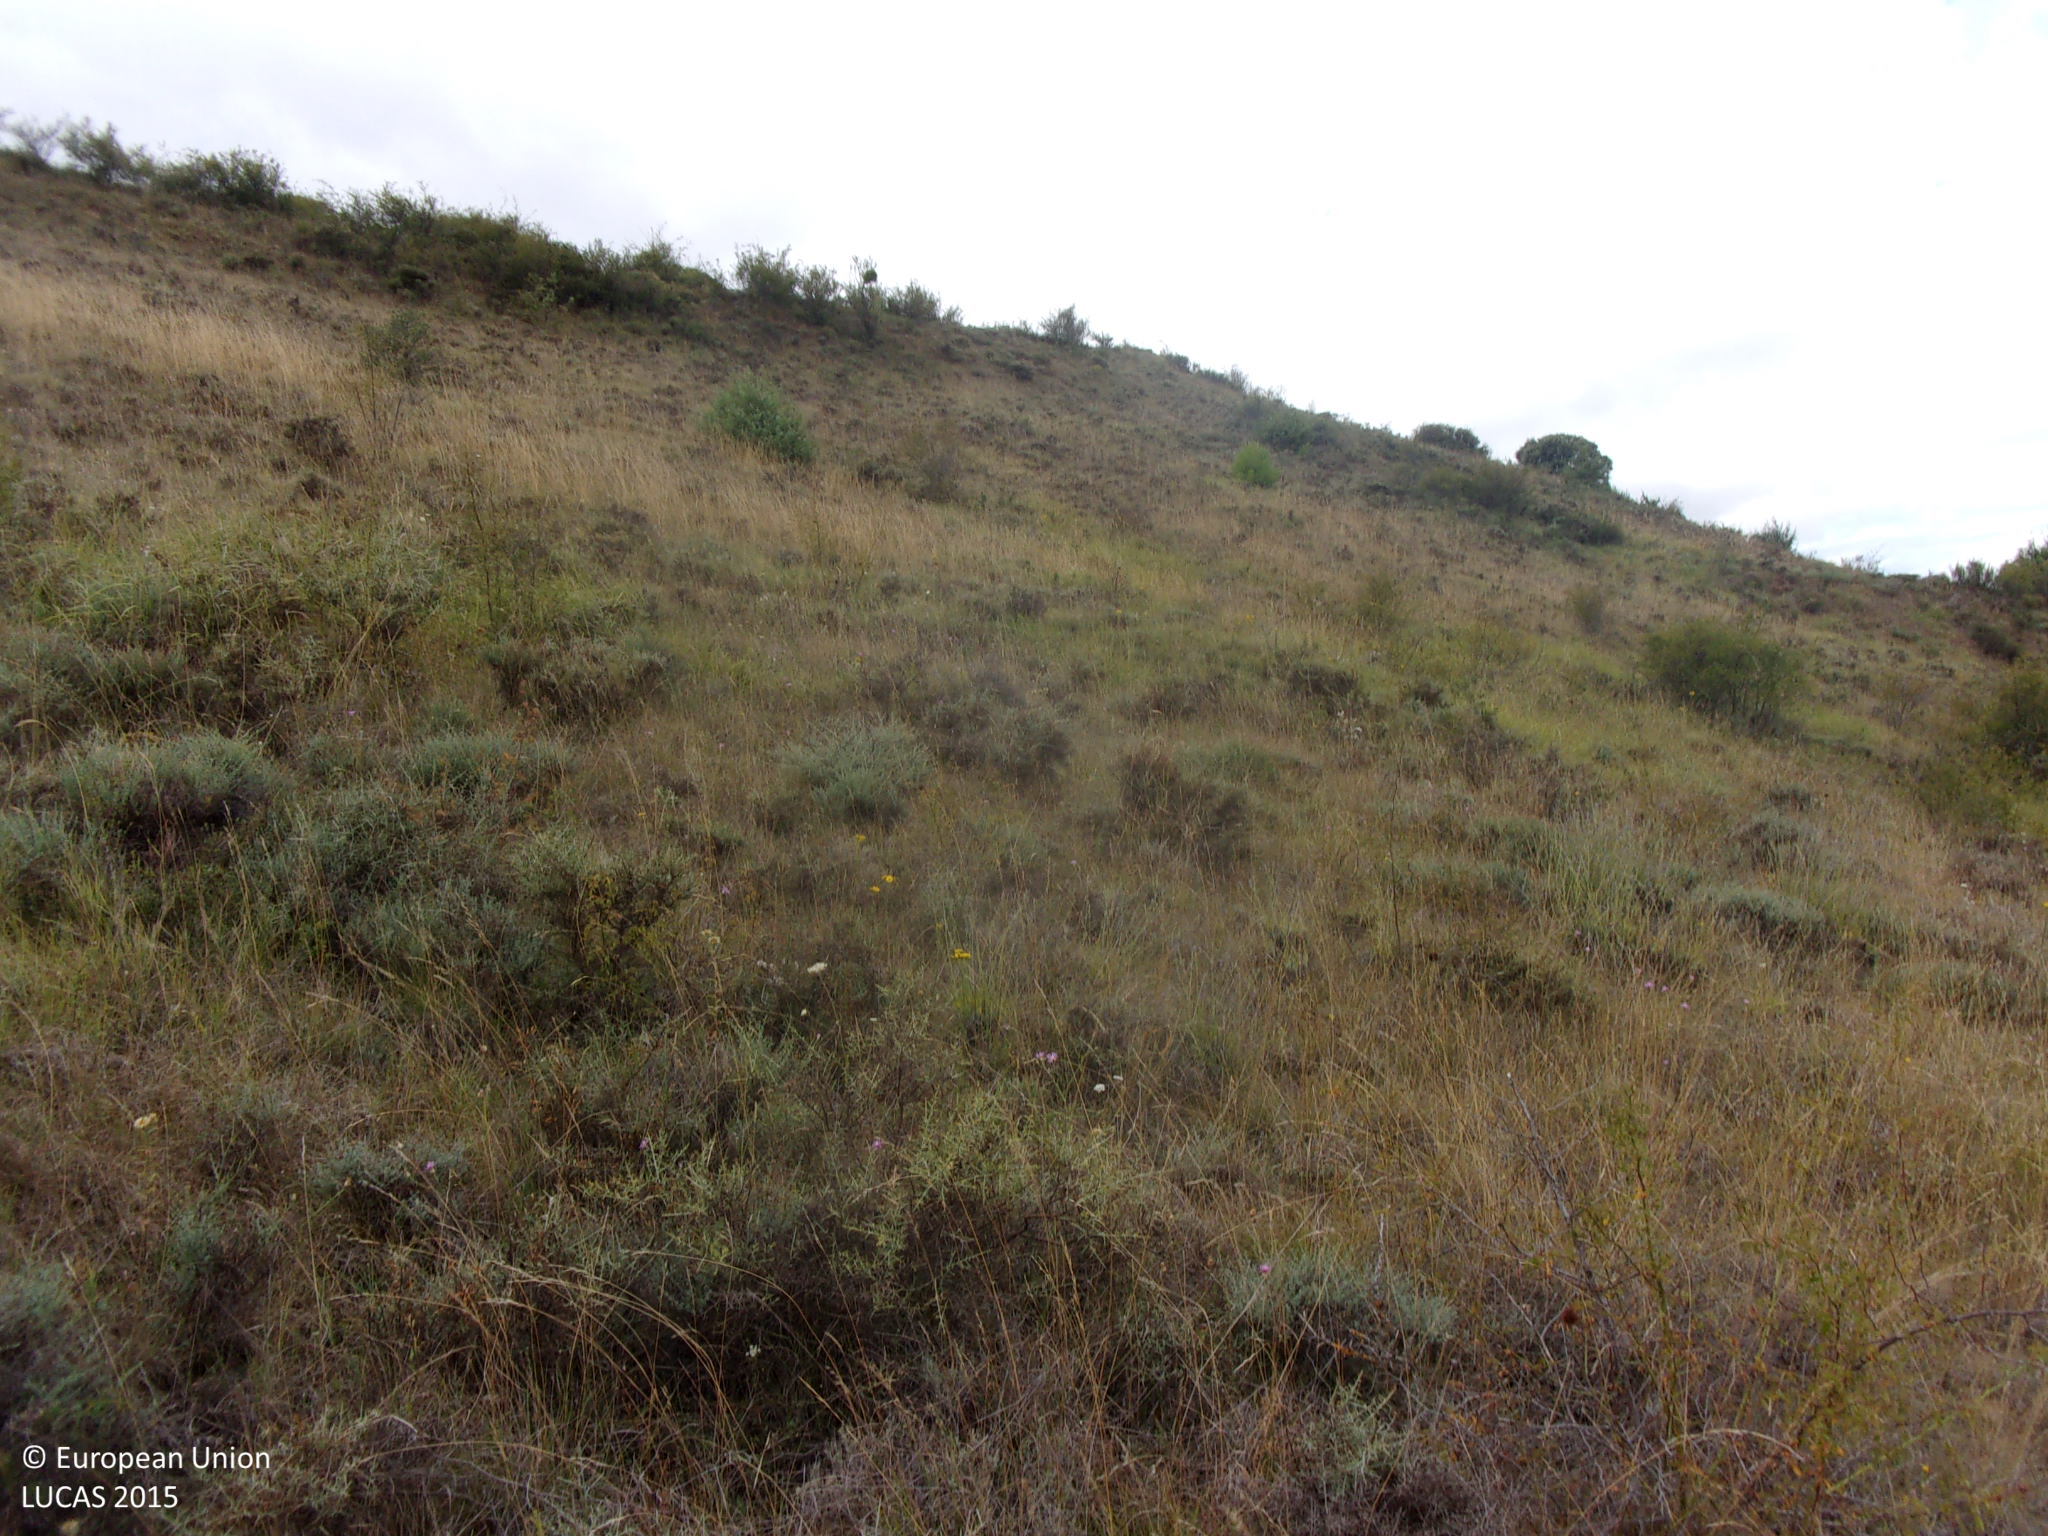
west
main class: Shrubland
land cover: Shrubland without tree cover
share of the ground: 50 - 75 %
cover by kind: shrubs 60 %, herbaceous plants 40 %
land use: Semi-natural and natural areas not in use
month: August
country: ES
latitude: 42.5410
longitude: -1.1982
